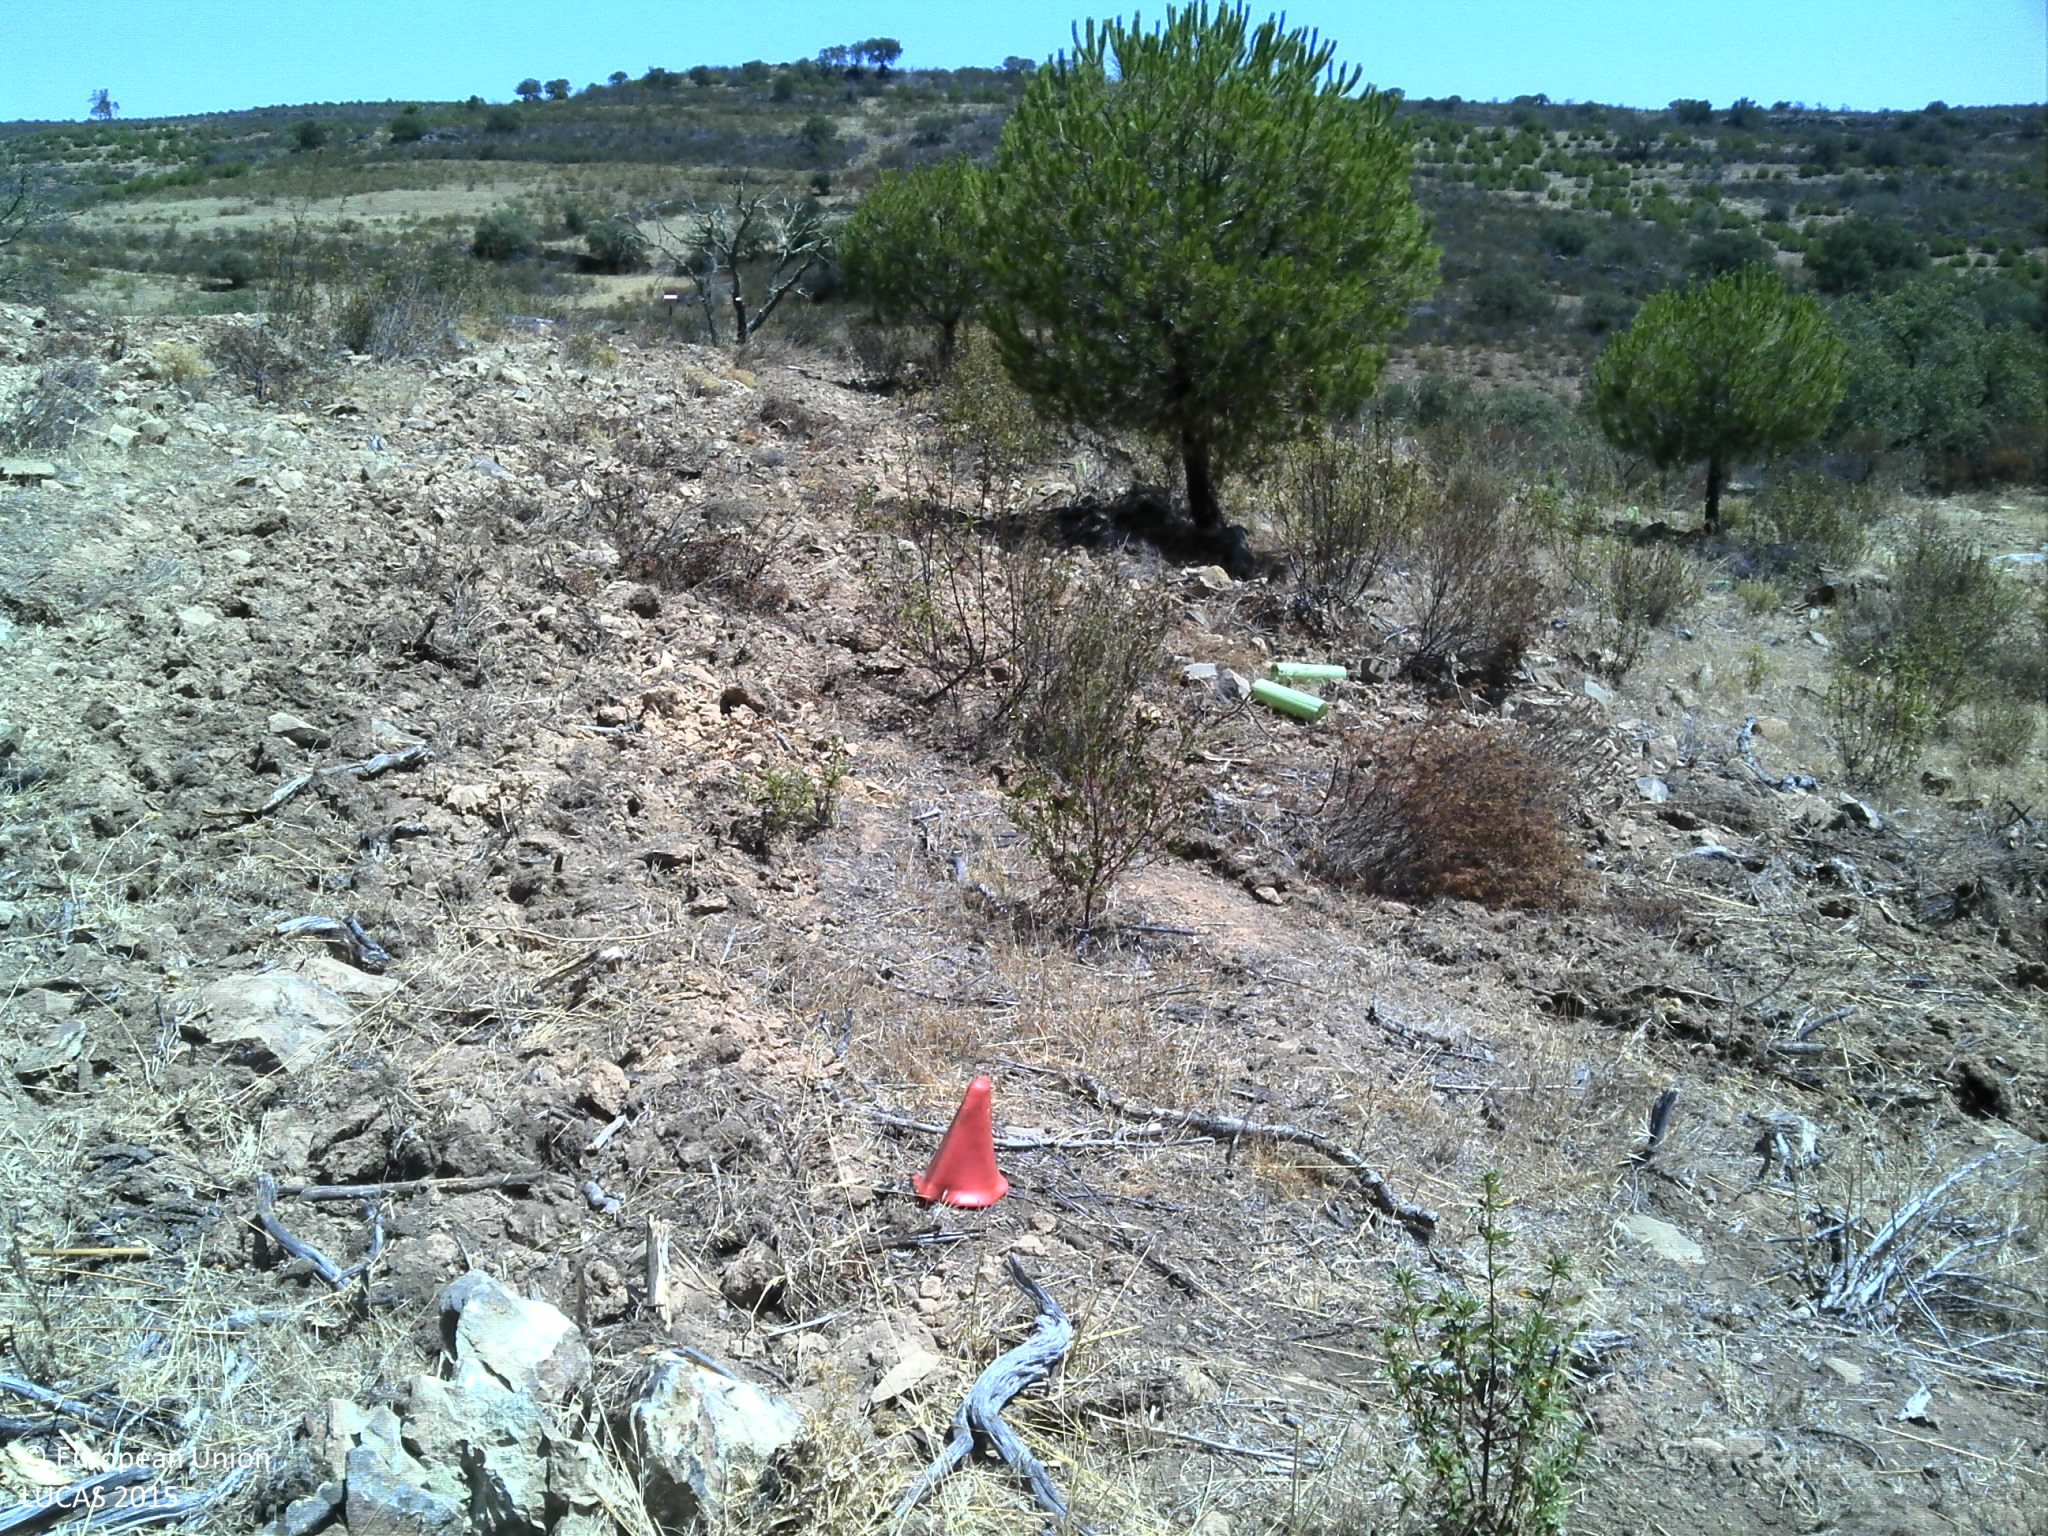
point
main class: Woodland
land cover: Pine dominated coniferous woodland
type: coniferous forest of the mediterranean region
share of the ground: 10 - 25 %
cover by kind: unconsolidated bare surface 55 %, coniferous forest trees 20 %, shrubs 20 %, herbaceous plants 5 %
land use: Forestry
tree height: < 5 m
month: July
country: PT
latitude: 37.4779
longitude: -7.8032
